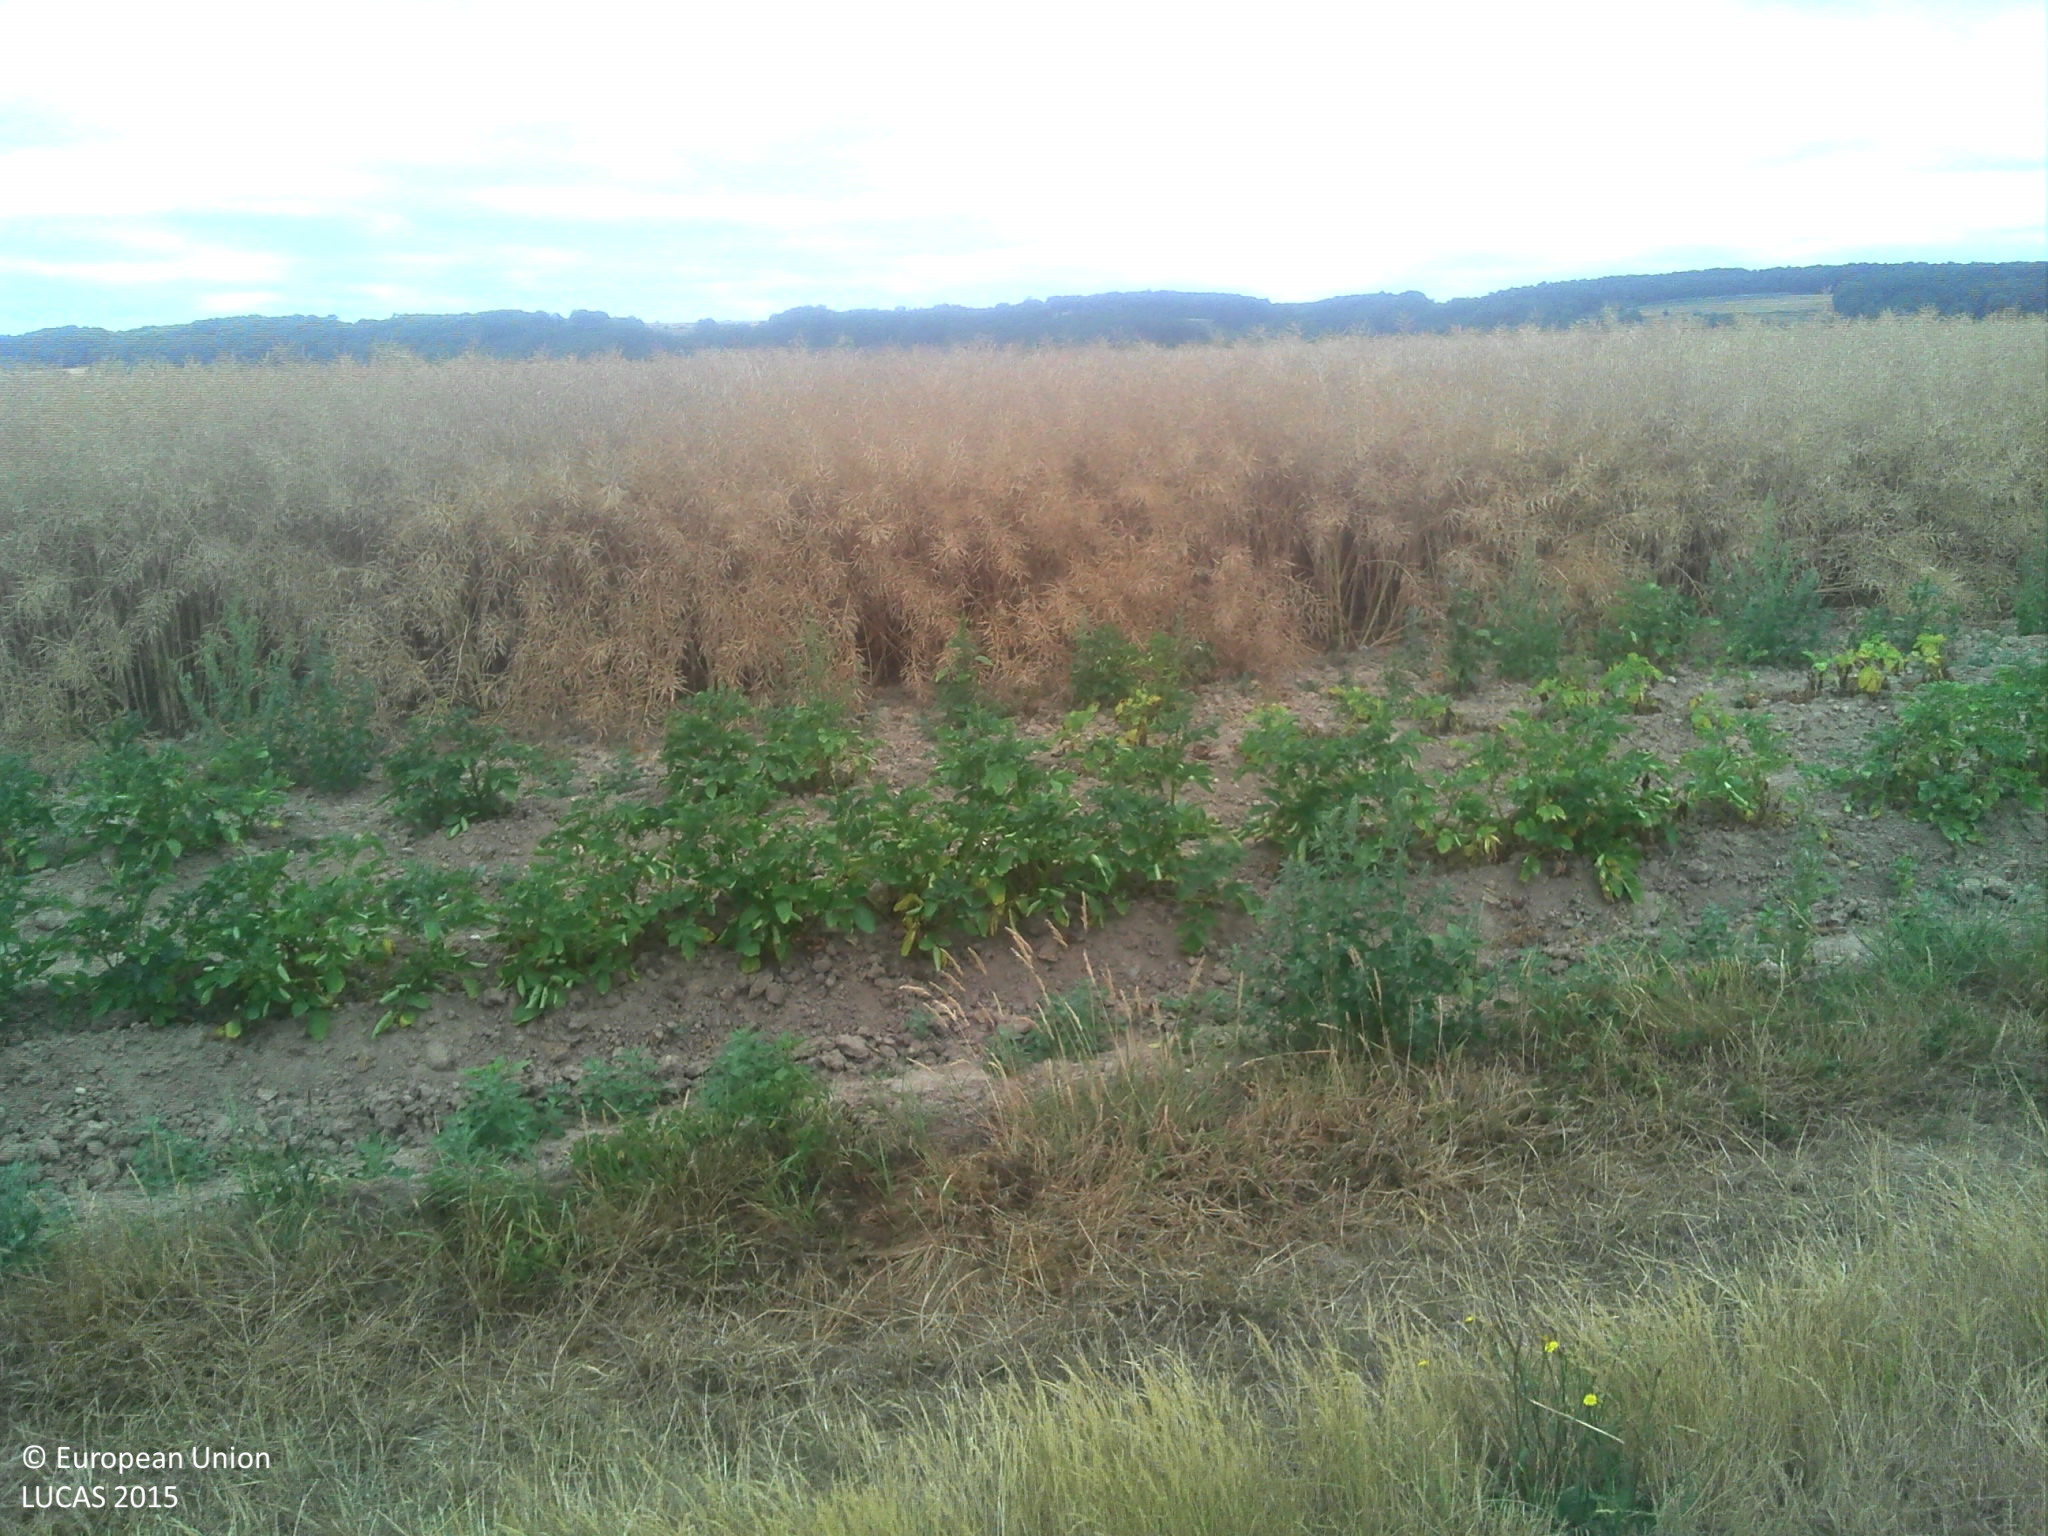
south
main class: Grassland
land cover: Grassland with sparse tree/shrub cover
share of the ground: > 75 %
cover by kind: herbaceous plants 95 %, broadleaved forest trees 5 %
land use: Agriculture (excluding fallow land and kitchen gardens)
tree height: > 5 m
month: July
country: FR
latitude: 47.7579
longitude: 0.7077
